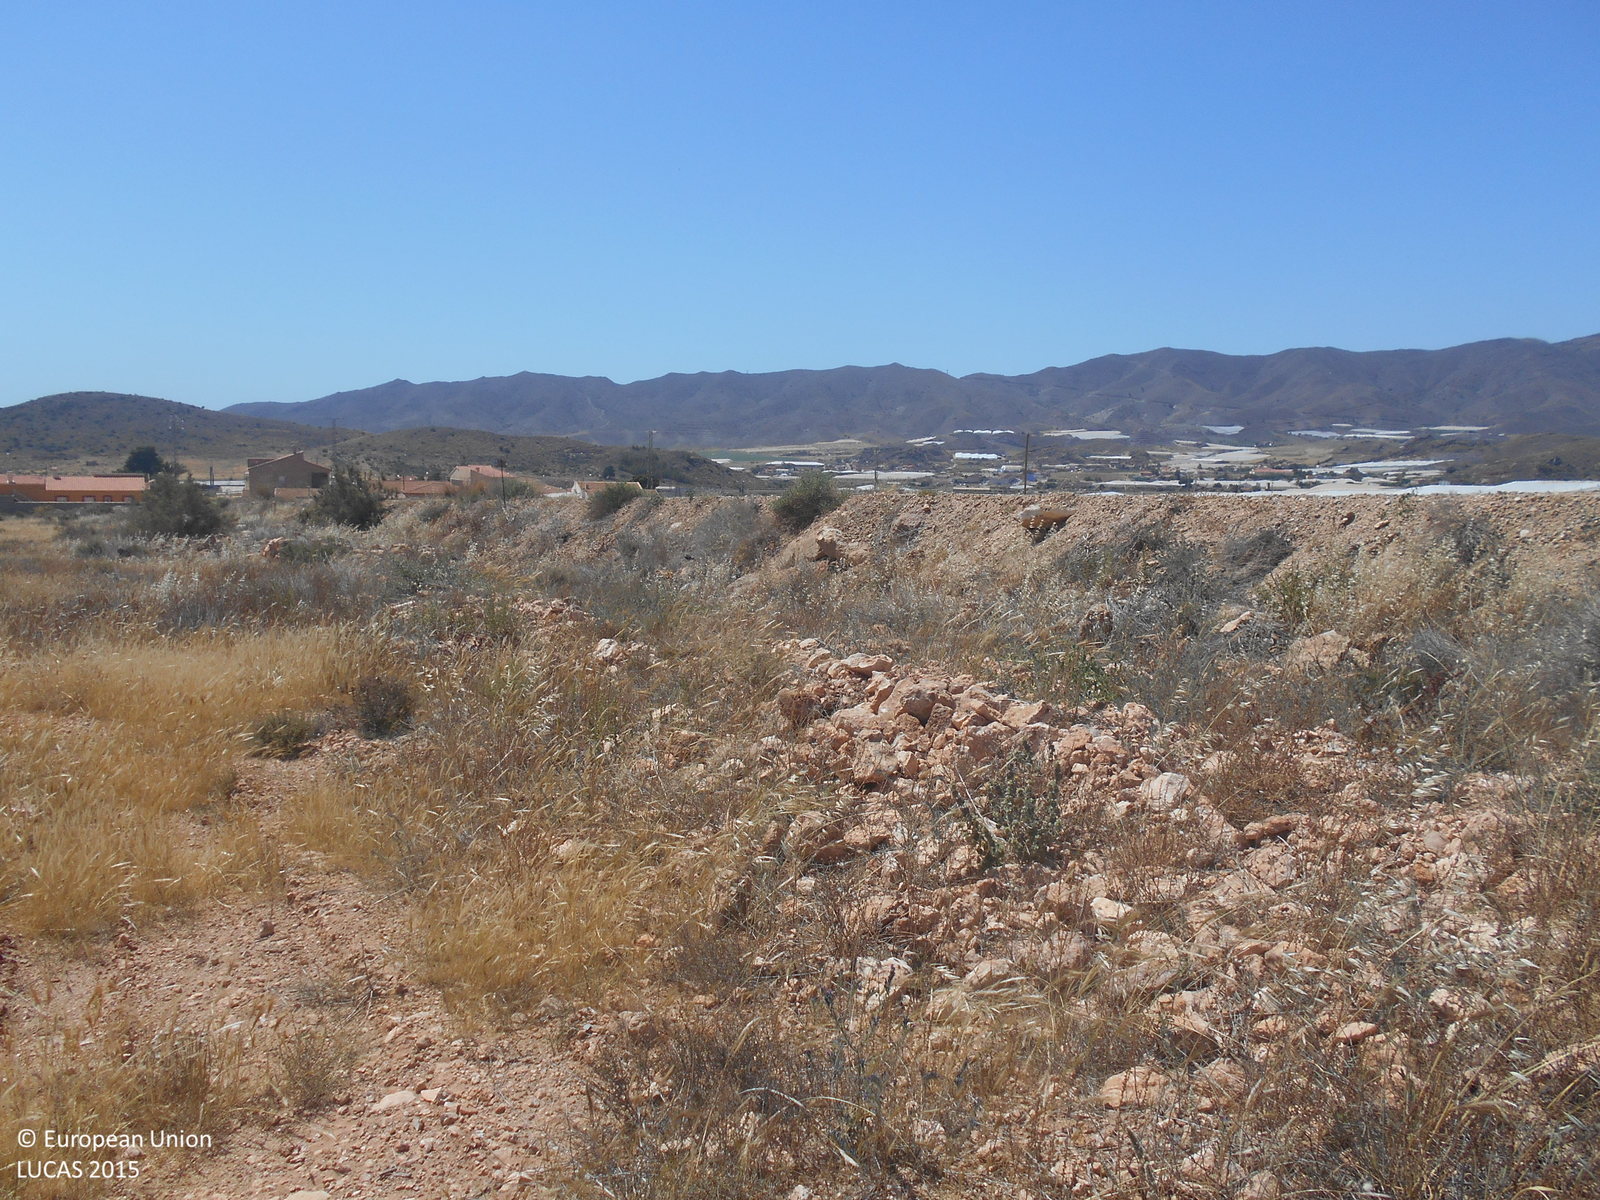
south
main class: Shrubland
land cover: Shrubland without tree cover
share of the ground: 50 - 75 %
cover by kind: herbaceous plants 40 %, shrubs 20 %, consolidated bare surface 20 %, unconsolidated bare surface 20 %
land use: Semi-natural and natural areas not in use
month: May
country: ES
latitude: 37.5481
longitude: -1.4456
